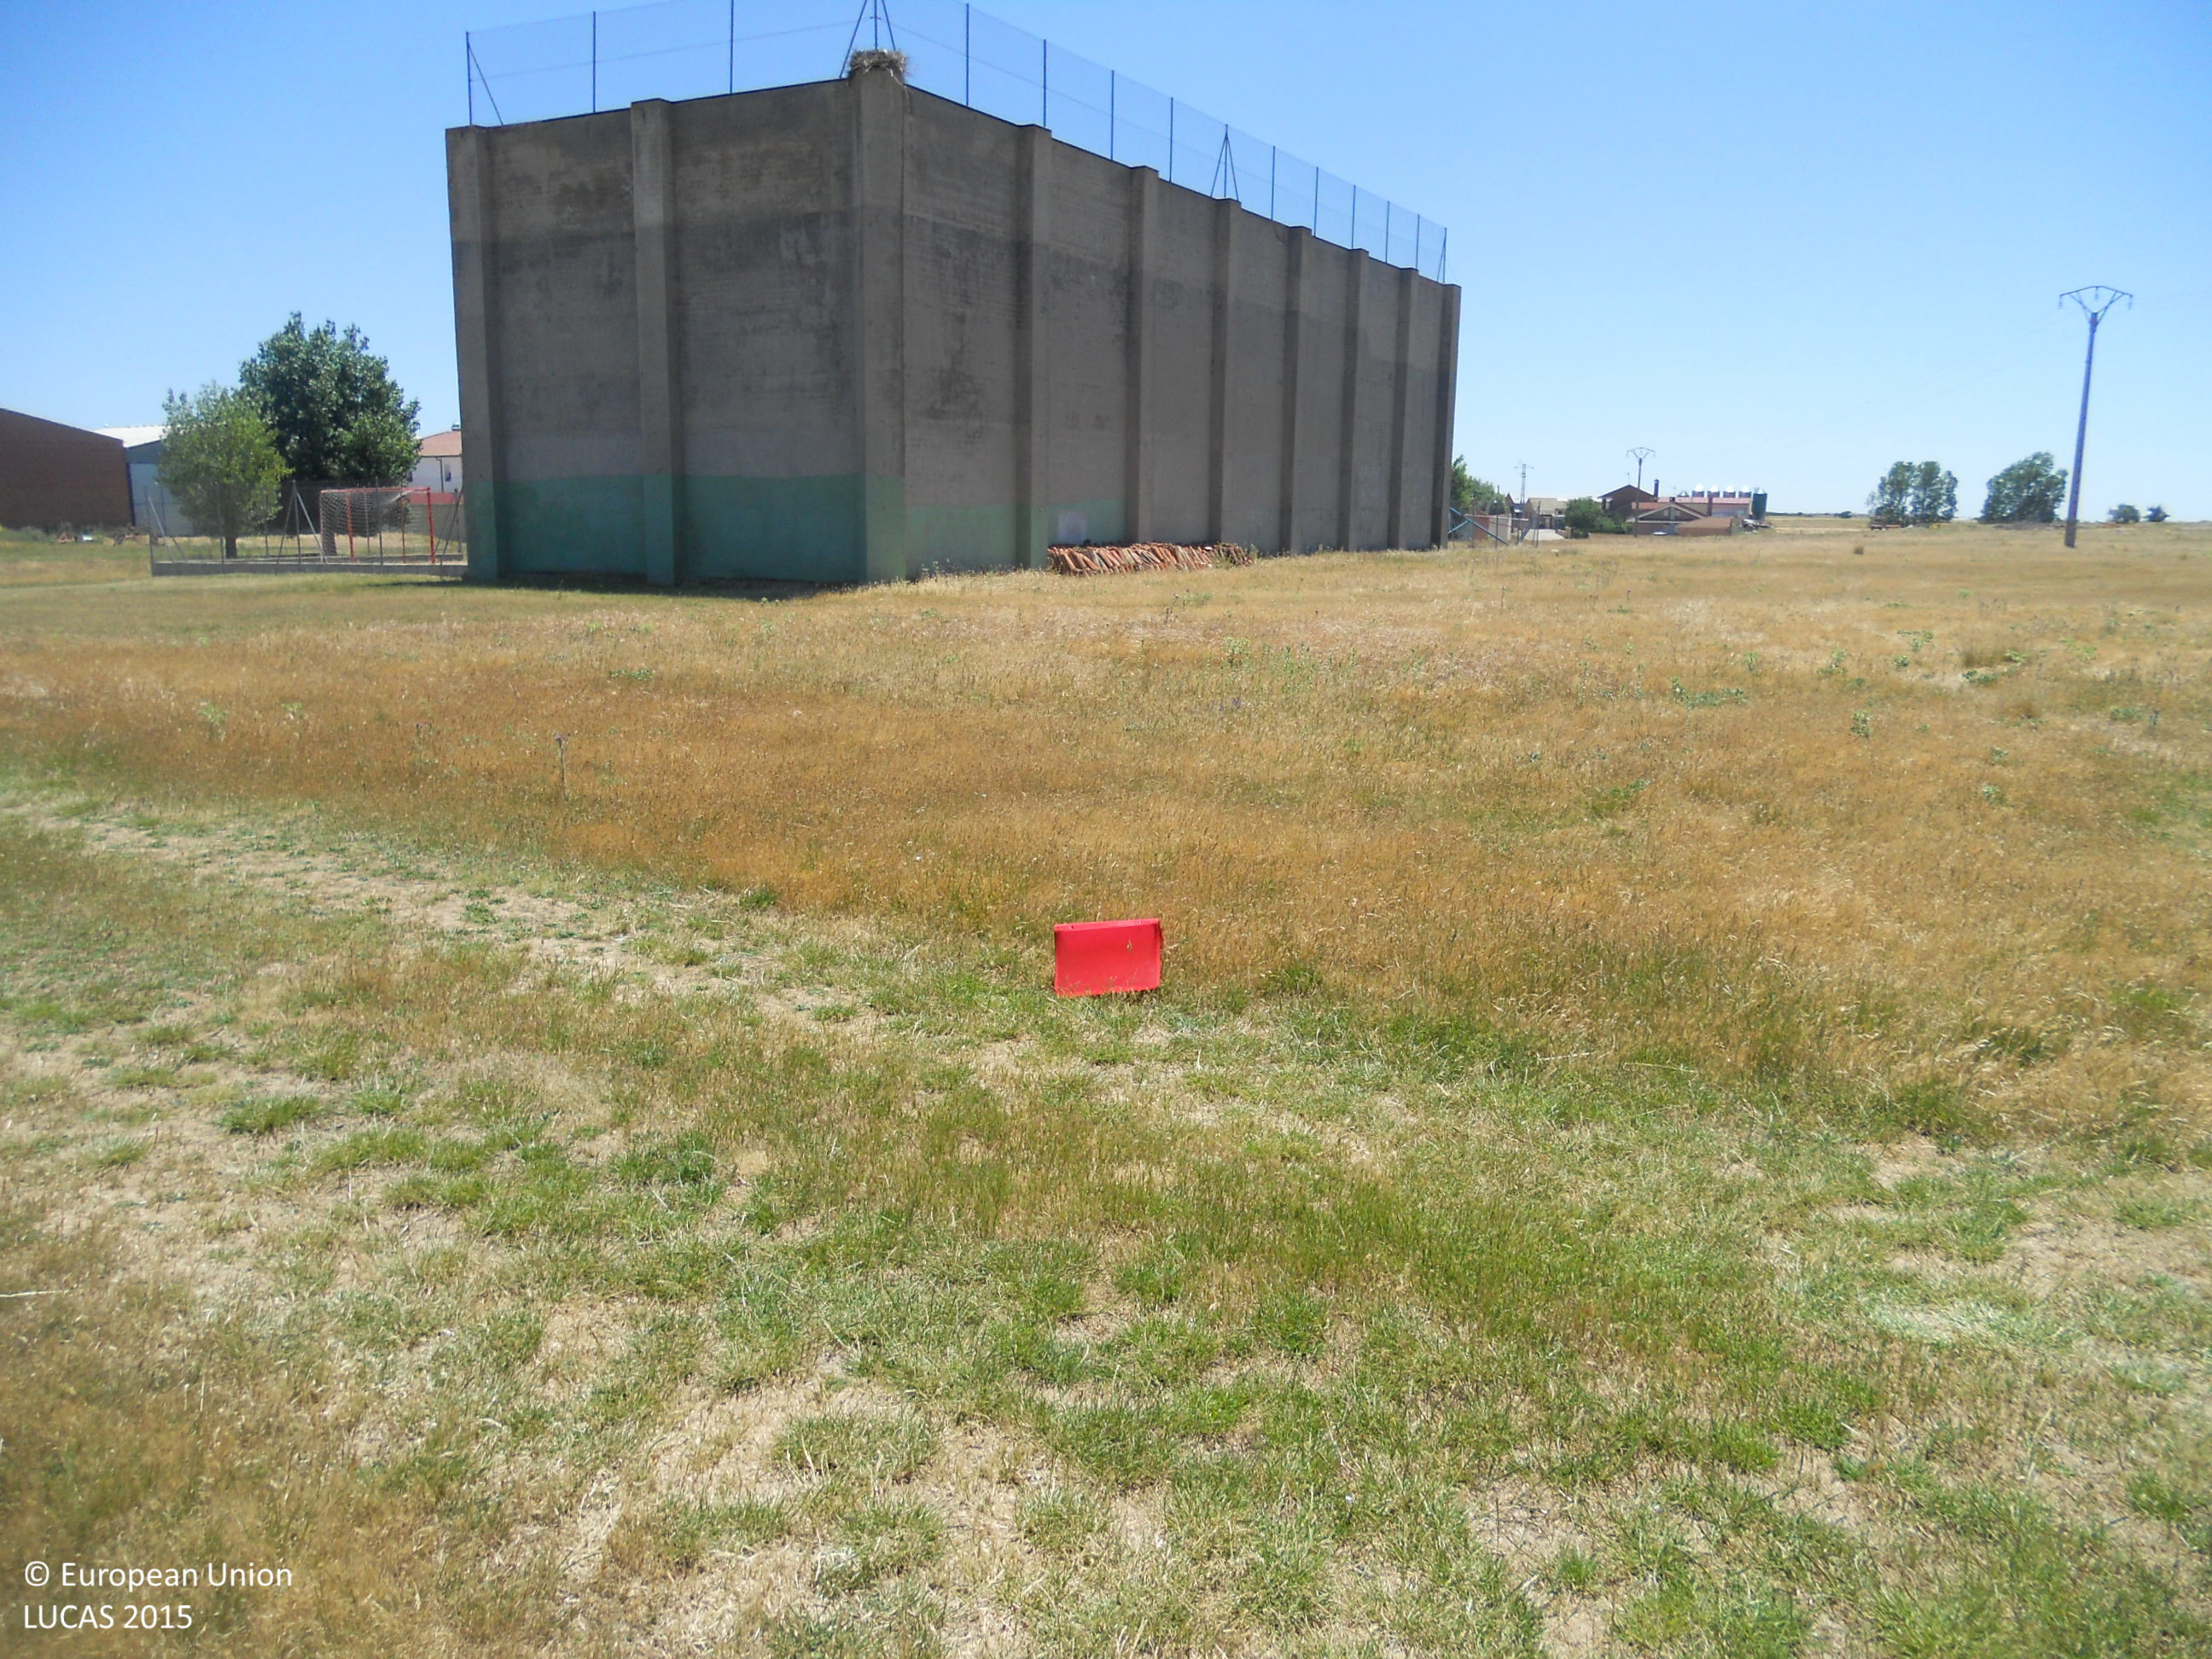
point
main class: Grassland
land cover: Grassland without tree/shrub cover
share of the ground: > 75 %
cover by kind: herbaceous plants 100 %
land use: Abandoned areas
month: June
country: ES
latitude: 42.5277
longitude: -4.8242
